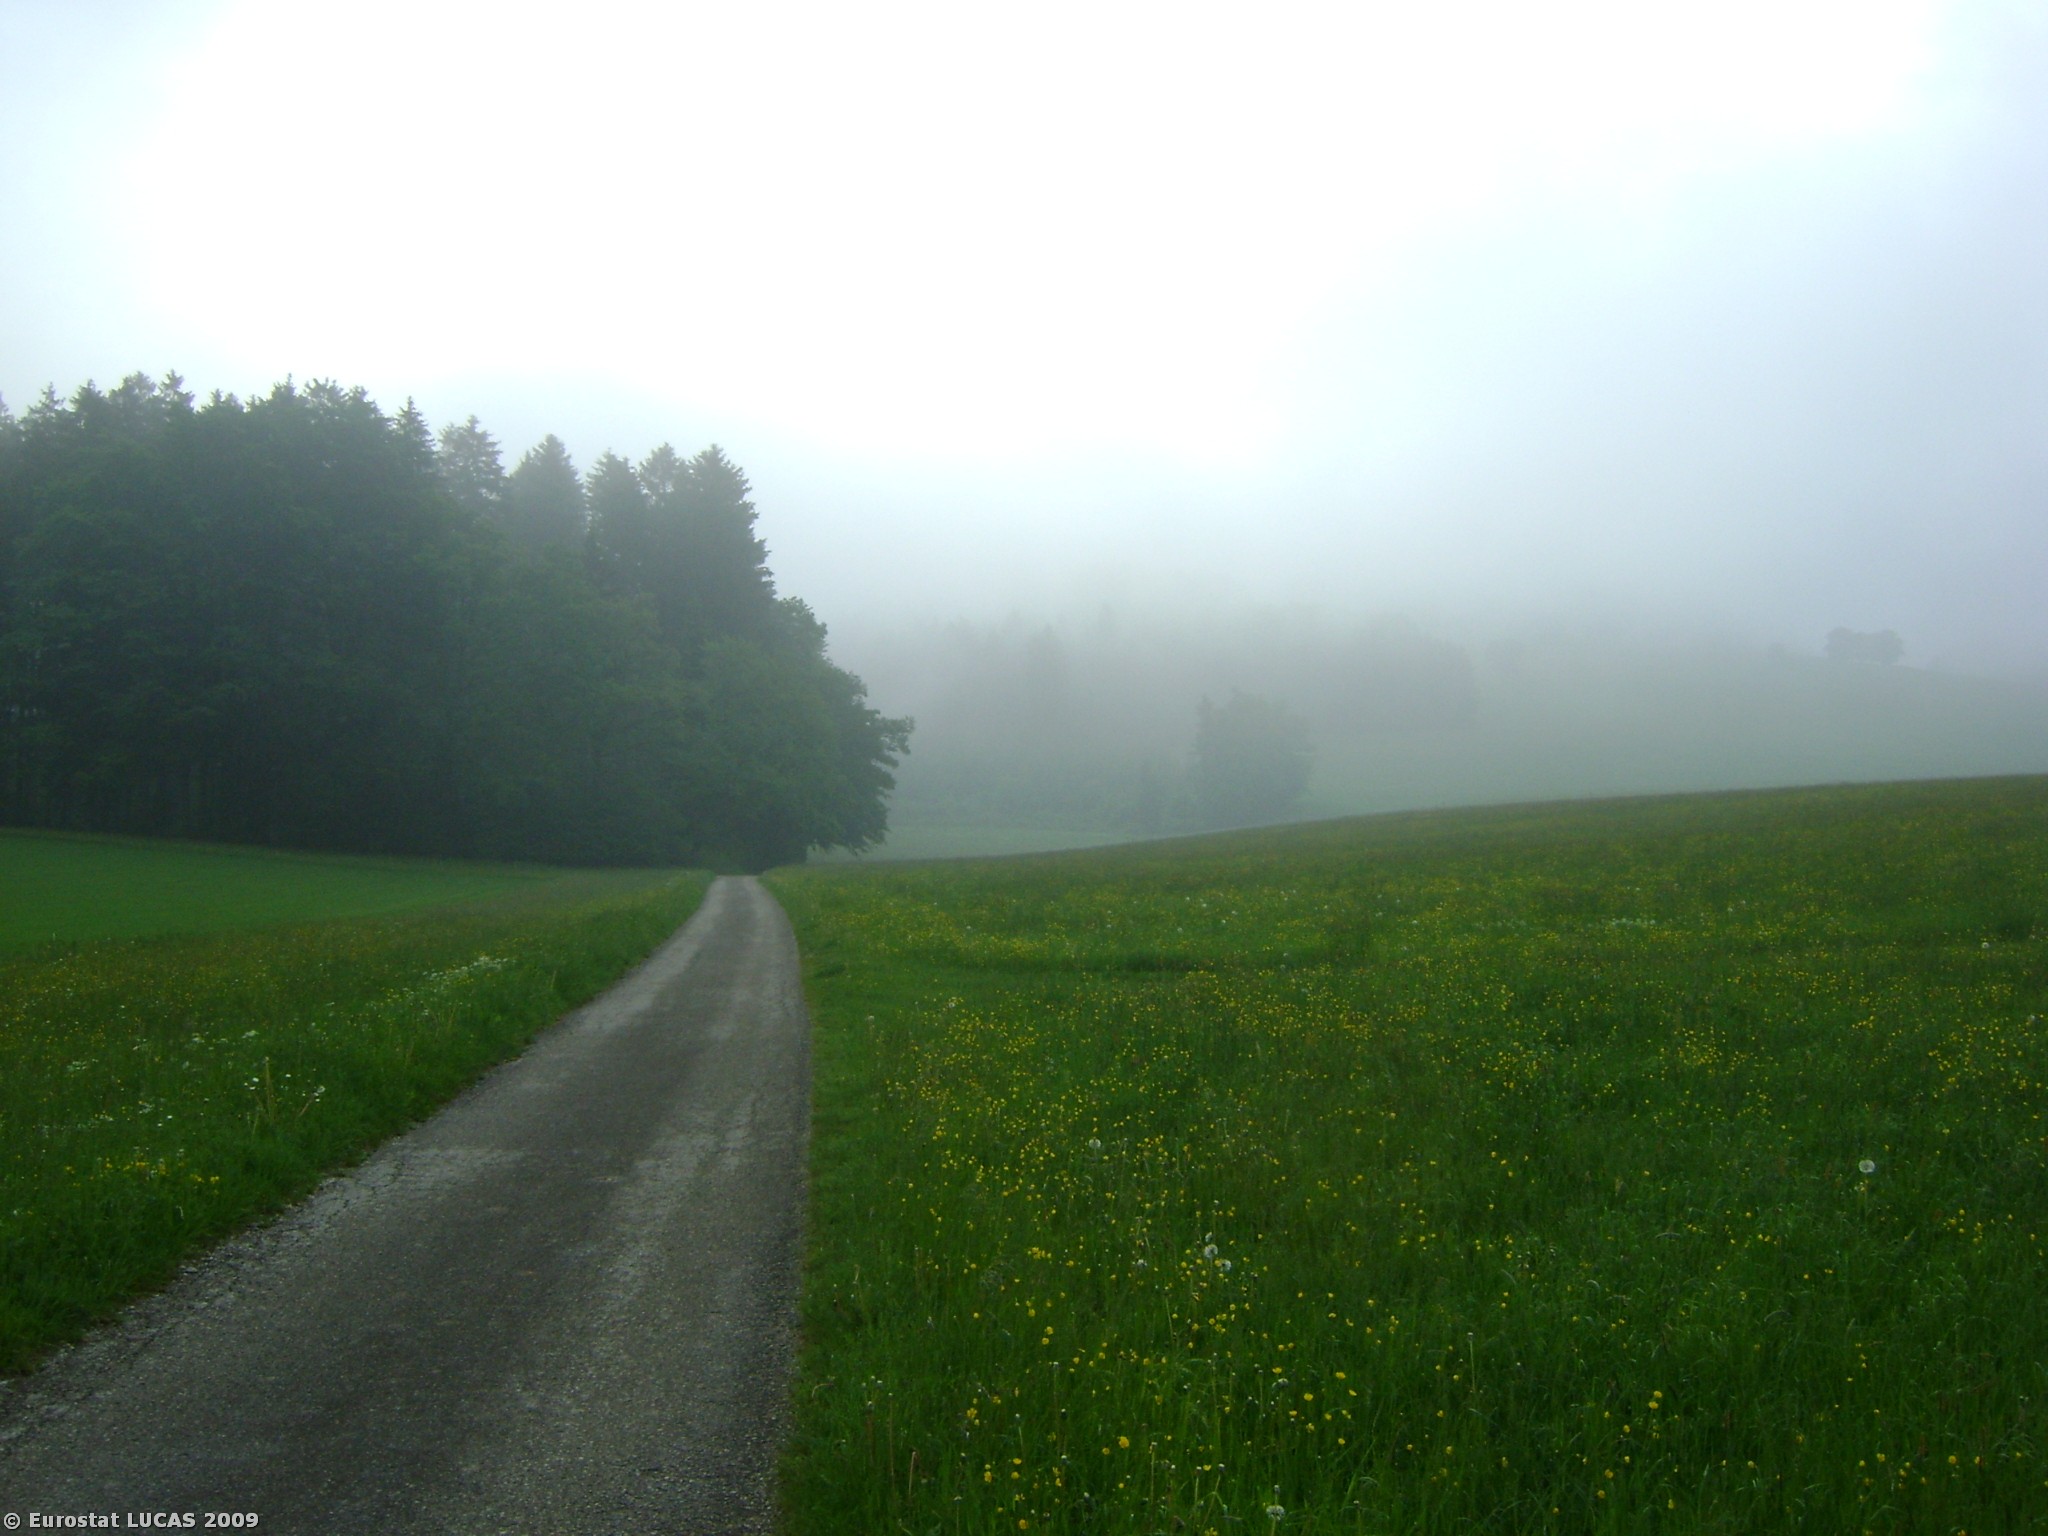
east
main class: Grassland
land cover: Grassland without tree/shrub cover
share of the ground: > 75 %
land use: Agriculture (excluding fallow land and kitchen gardens)
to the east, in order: Grassland without tree/shrub cover; Tracks; Grassland without tree/shrub cover; Paved roads, cycling and walking lanes; Grassland without tree/shrub cover; Tracks; Grassland without tree/shrub cover
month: May
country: AT
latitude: 47.9594
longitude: 13.2531
